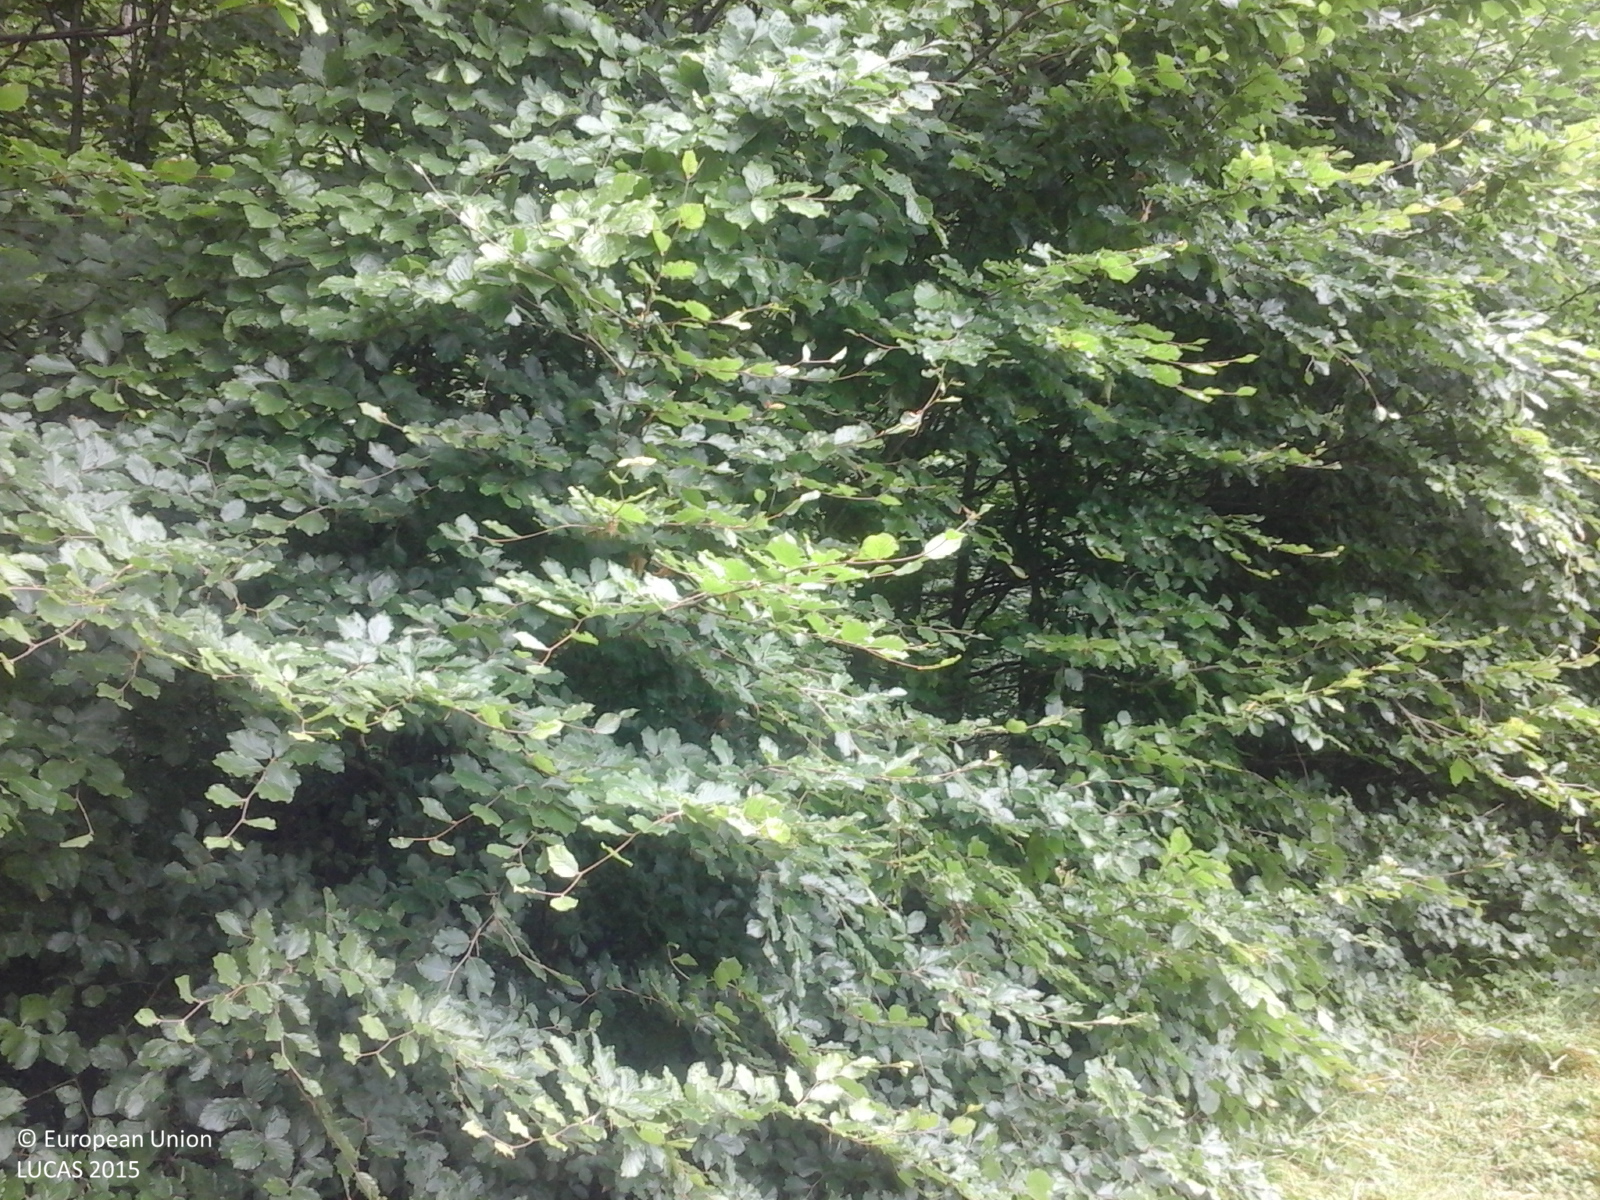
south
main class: Woodland
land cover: Broadleaved woodland
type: beech forest
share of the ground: > 75 %
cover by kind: broadleaved forest trees 100 %
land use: Forestry
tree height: > 5 m
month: July
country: RO
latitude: 45.3510
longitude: 24.8013
